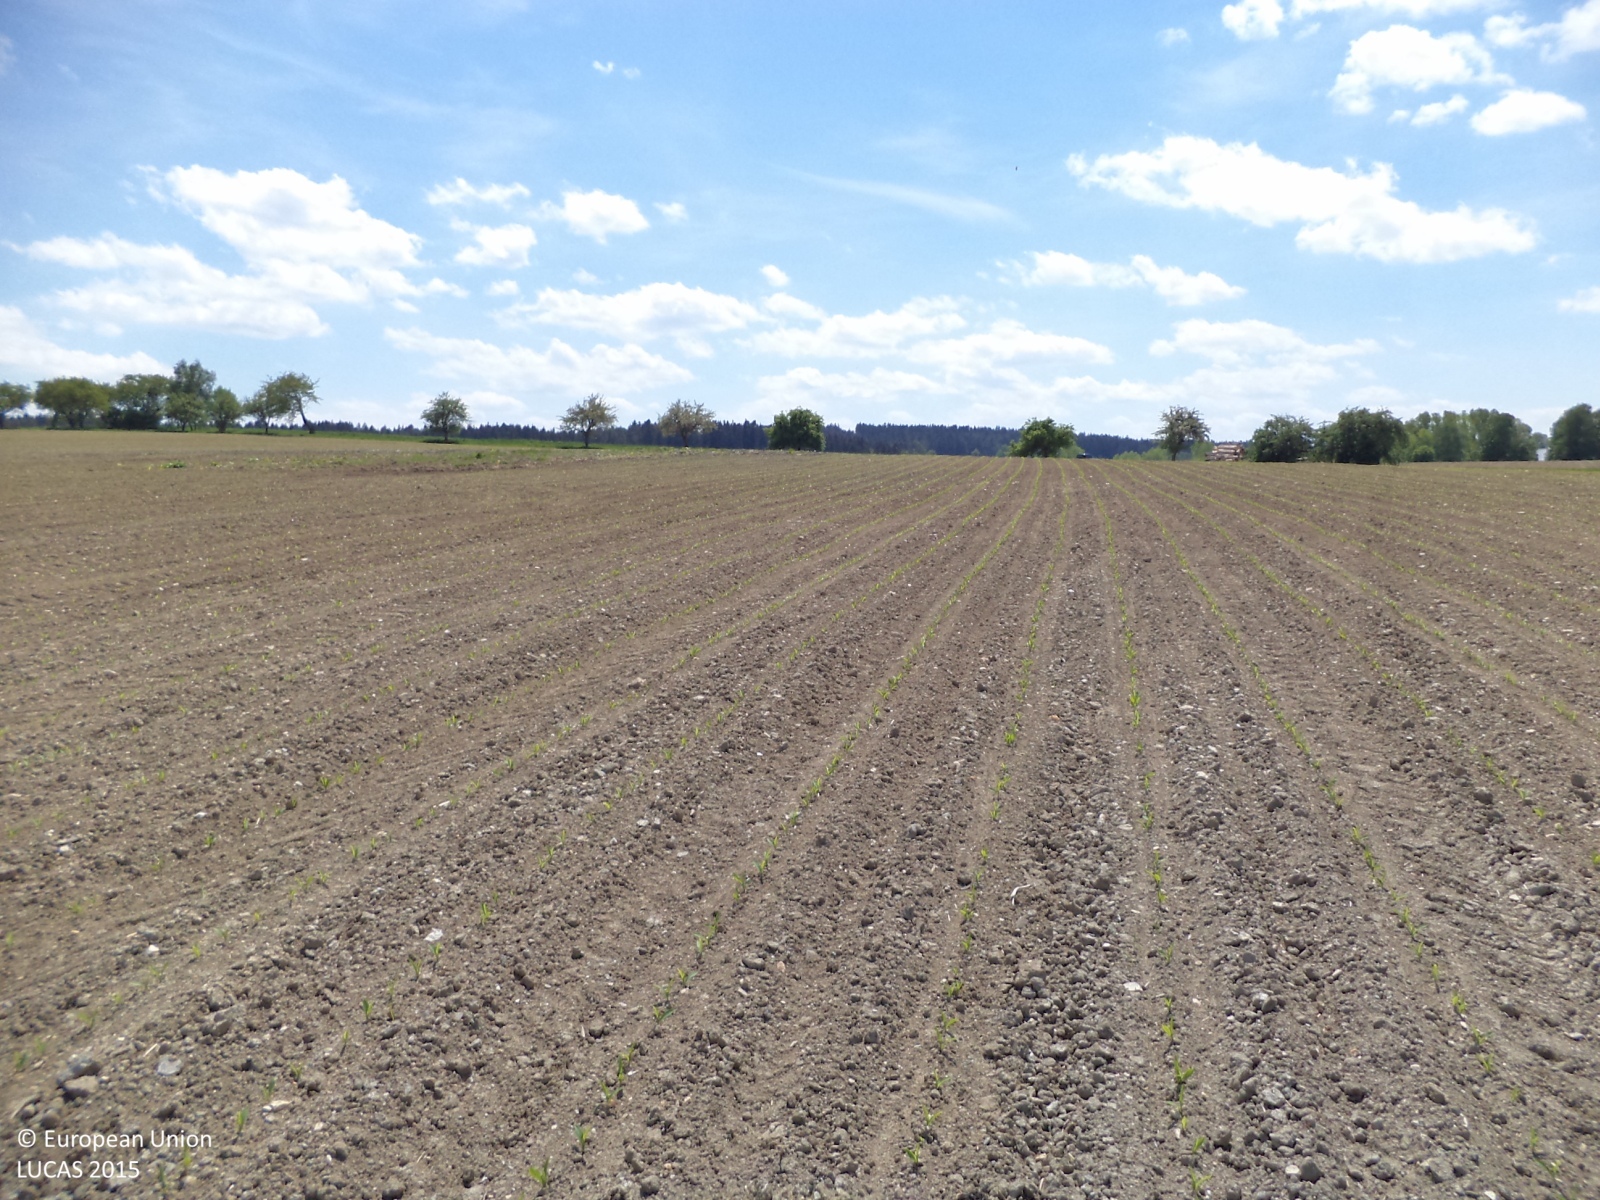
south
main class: Cropland
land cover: Maize
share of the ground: 10 - 25 %
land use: Agriculture (excluding fallow land and kitchen gardens)
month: May
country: CZ
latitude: 49.3216
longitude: 14.9137
